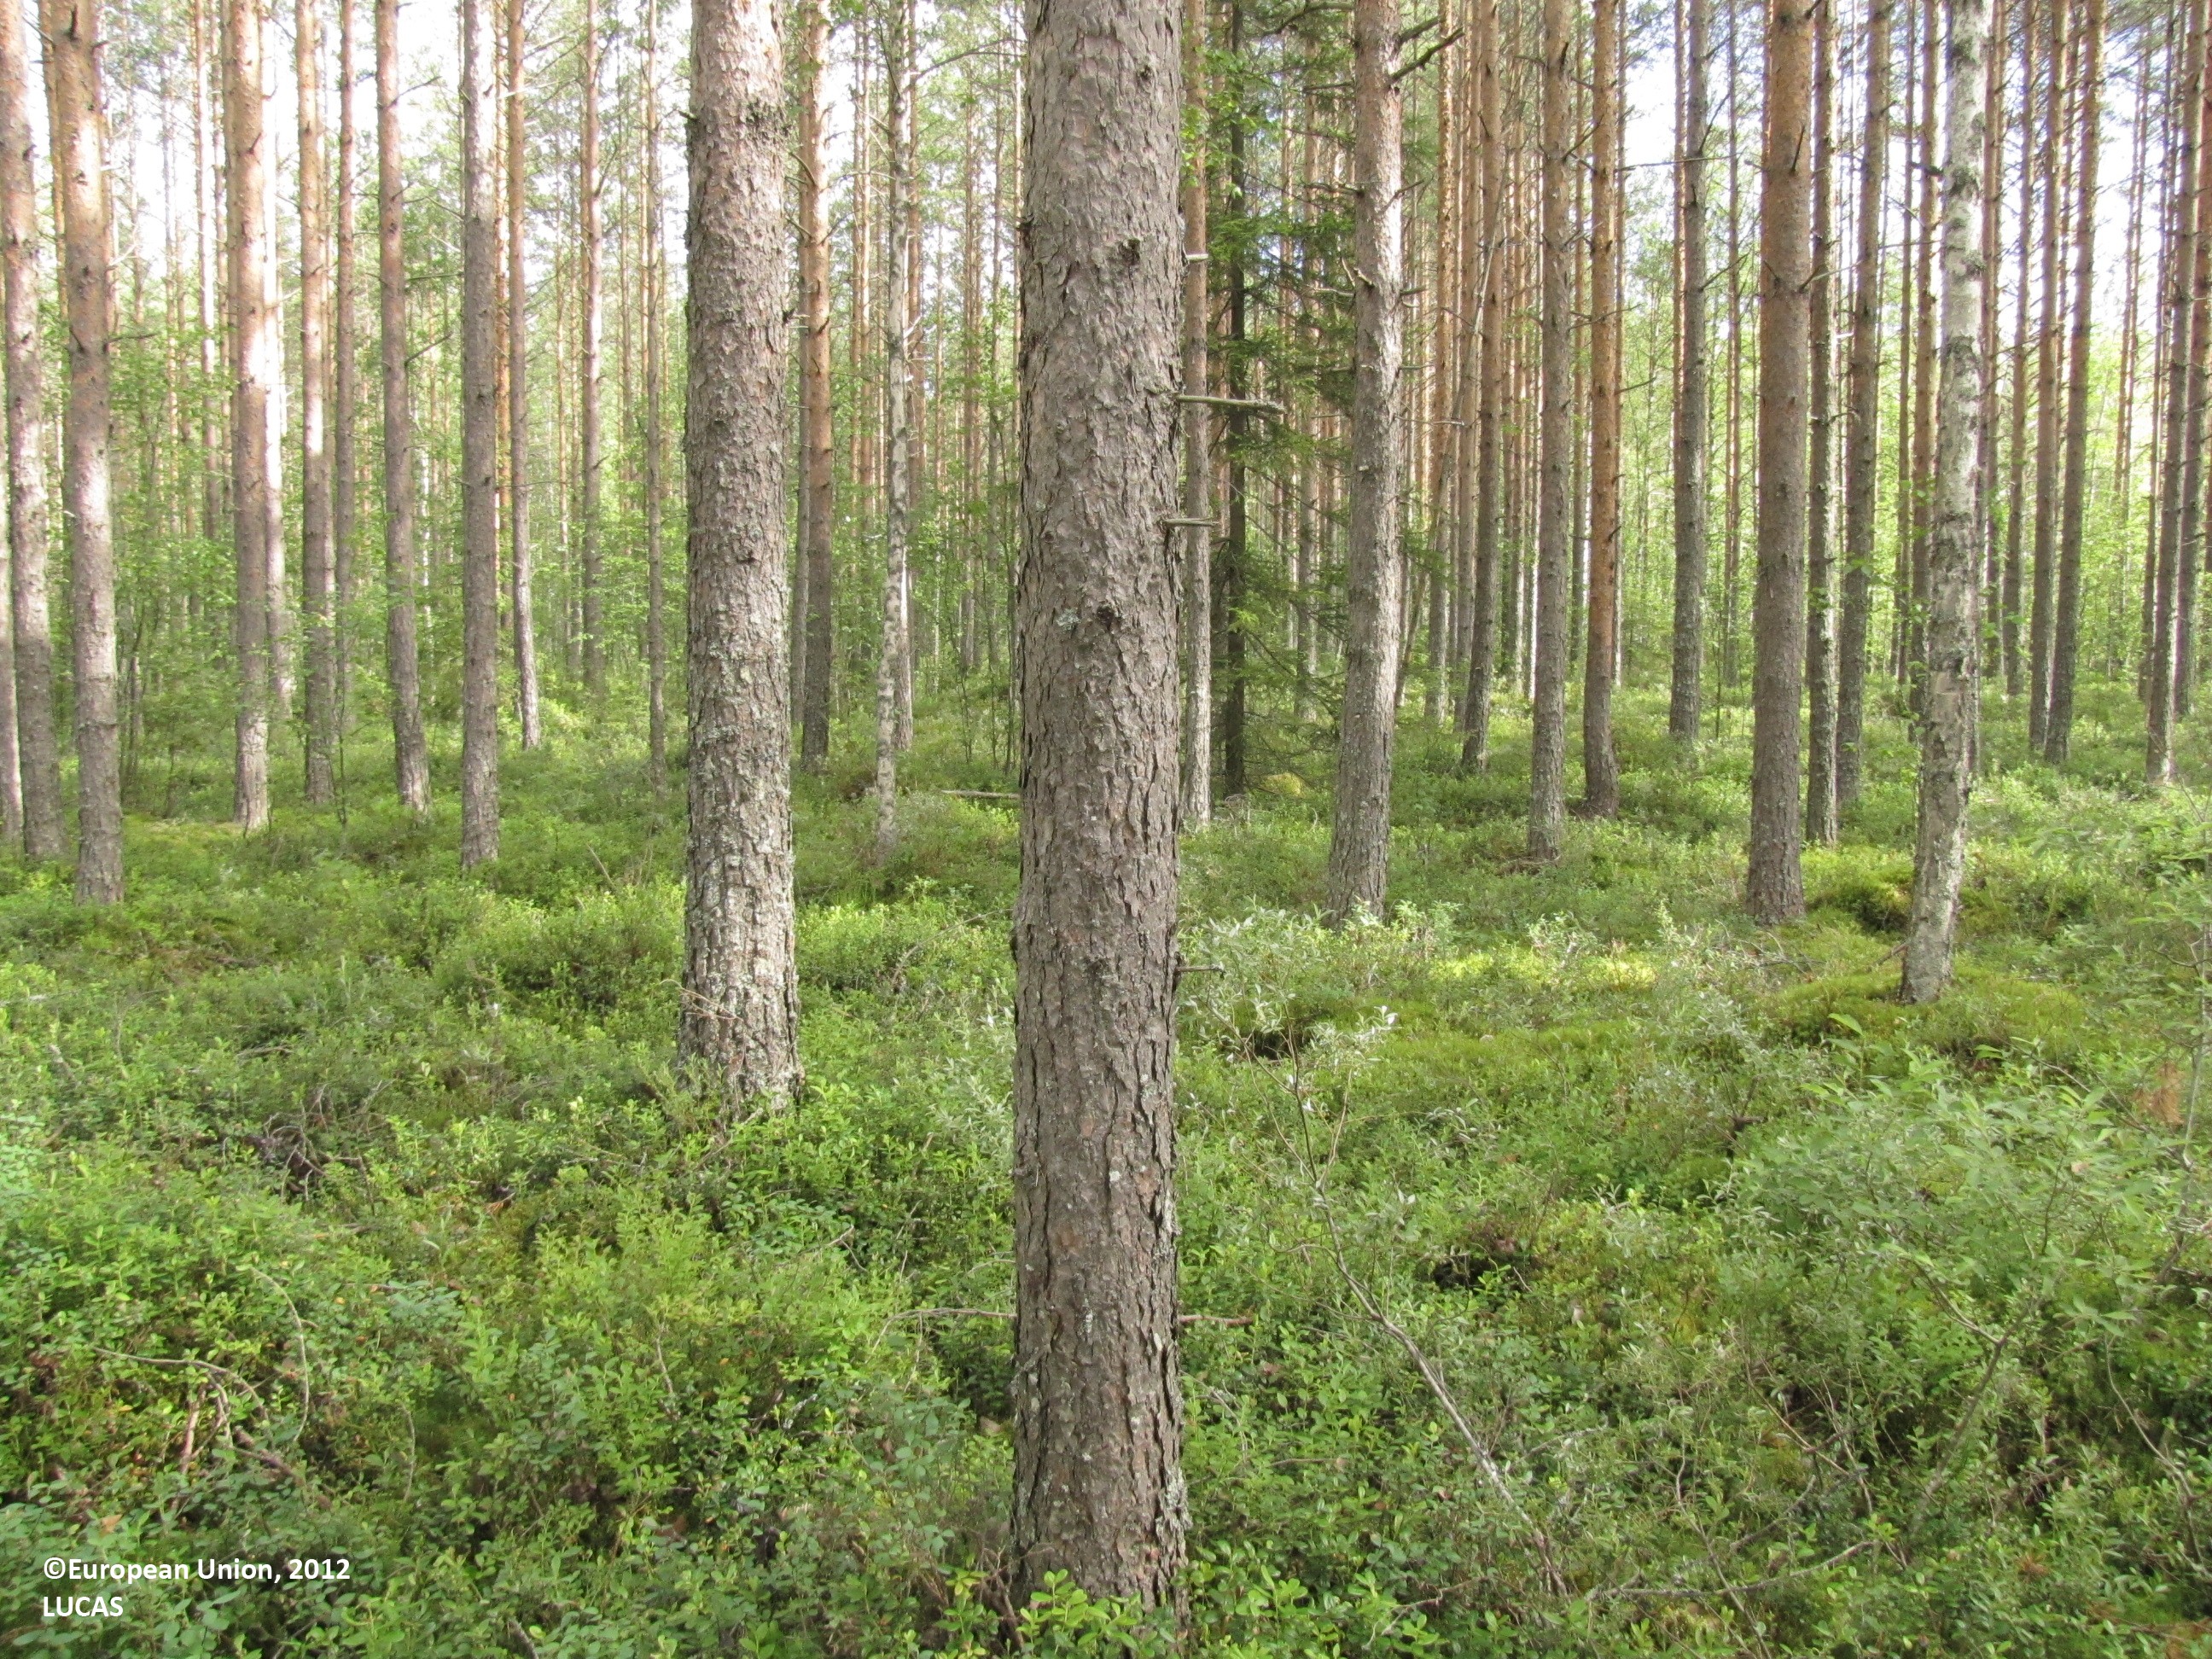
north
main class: Woodland
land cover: Pine dominated coniferous woodland
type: boreal forest
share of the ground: > 75 %
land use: Forestry
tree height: > 5 m
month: July
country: FI
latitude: 62.3171
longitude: 23.2466
